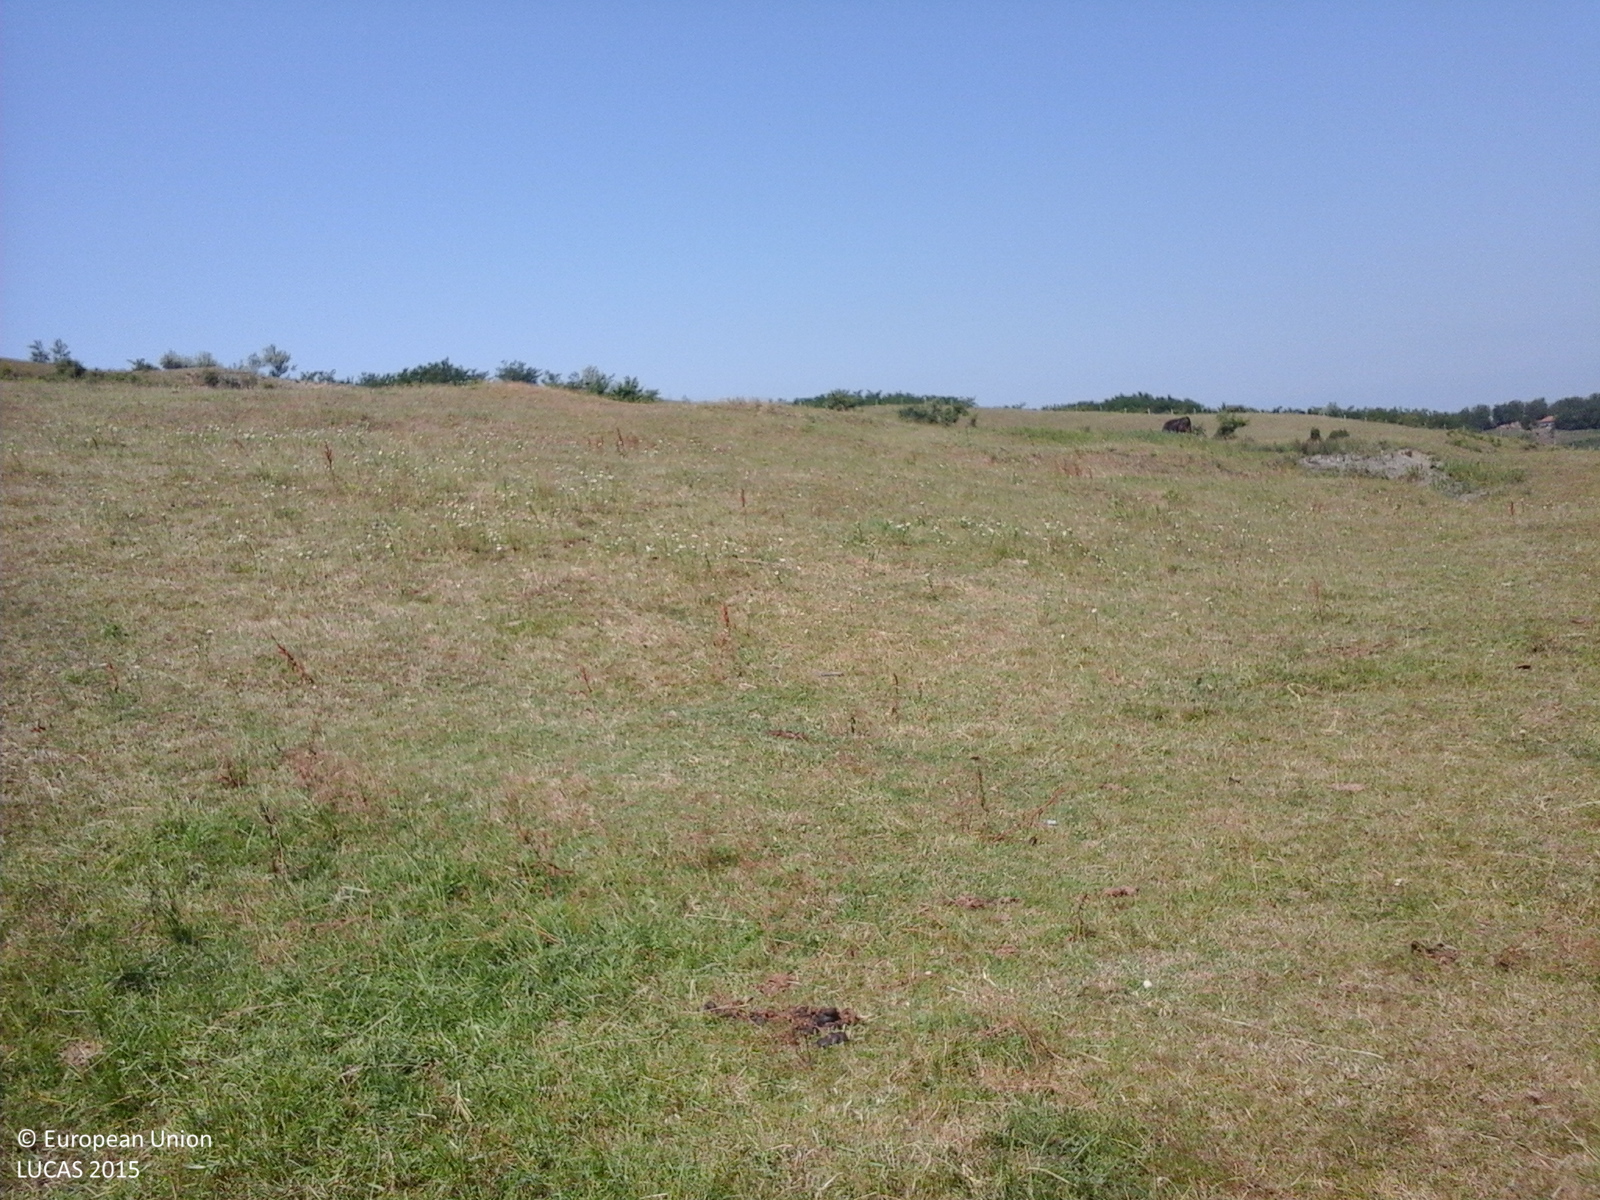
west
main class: Grassland
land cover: Grassland without tree/shrub cover
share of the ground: > 75 %
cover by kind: herbaceous plants 100 %
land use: Agriculture (excluding fallow land and kitchen gardens)
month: June
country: RO
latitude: 46.9358
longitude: 27.8446
